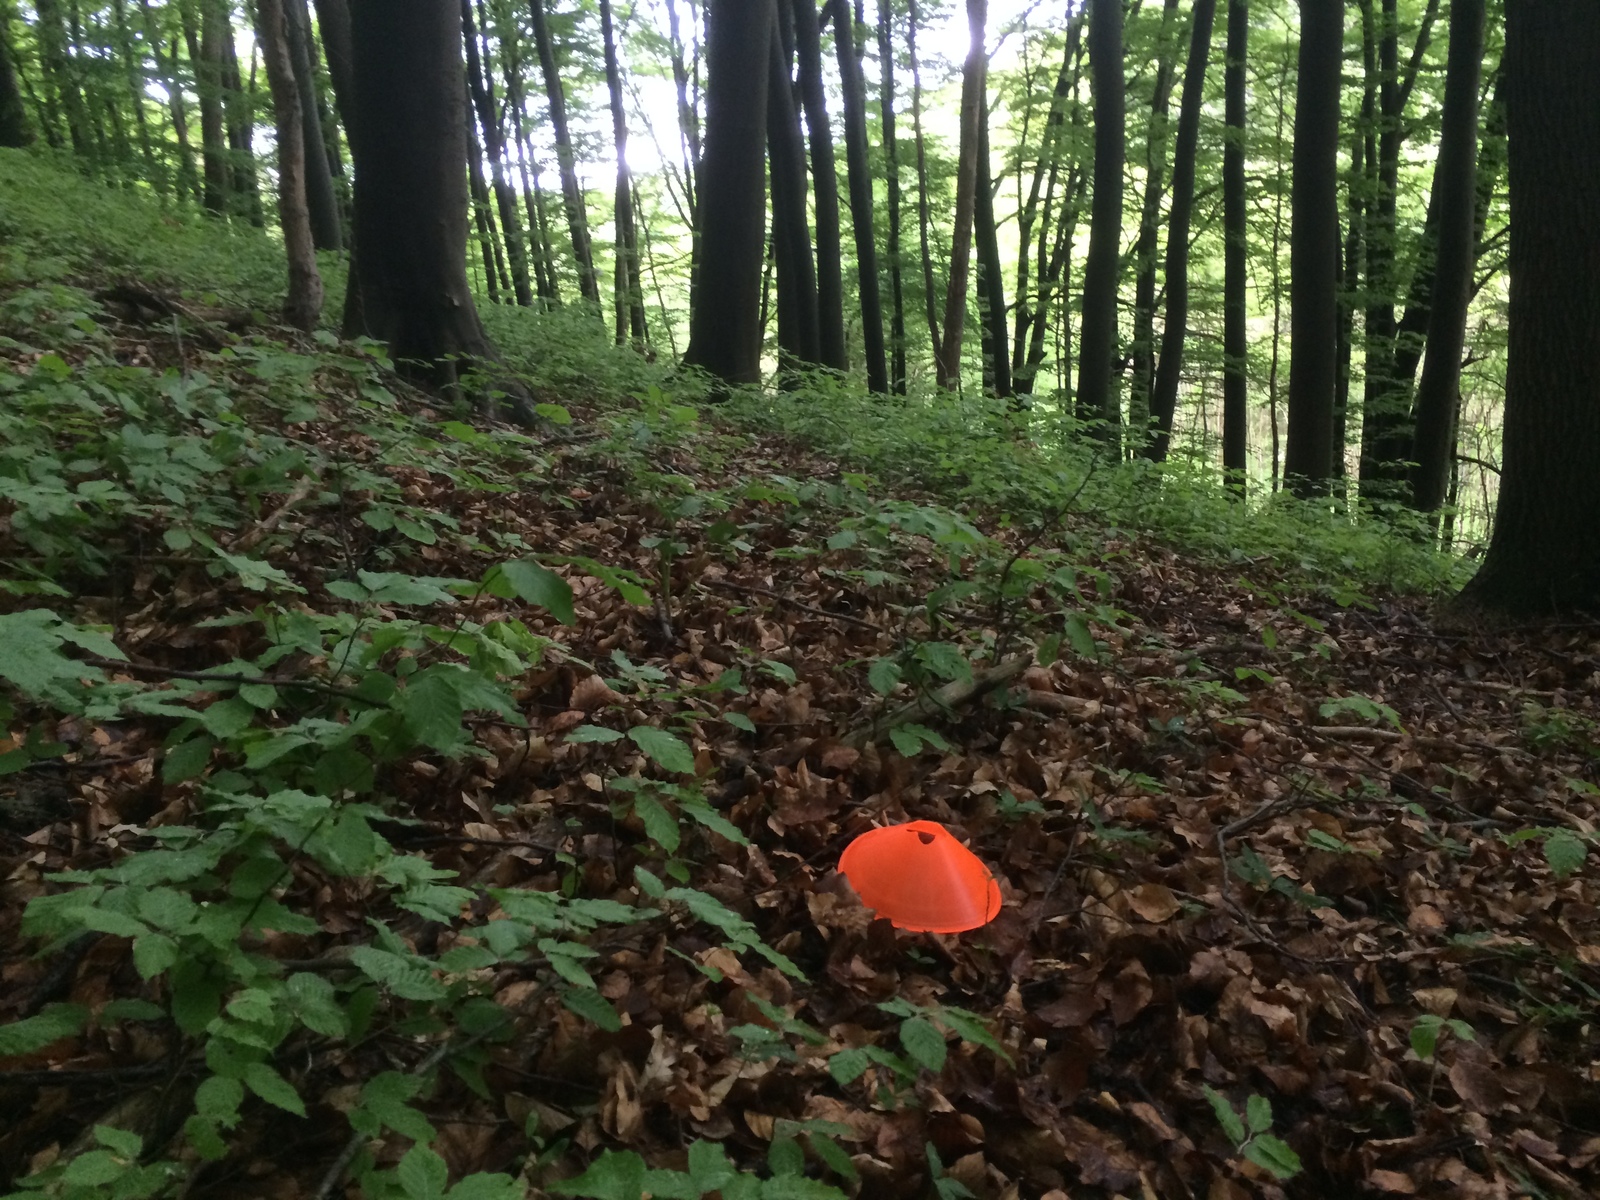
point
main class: Woodland
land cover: Broadleaved woodland
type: beech forest
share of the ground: > 75 %
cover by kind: broadleaved forest trees 100 %
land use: Forestry
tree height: > 5 m
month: May
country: AT
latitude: 48.1050
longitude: 16.1684
